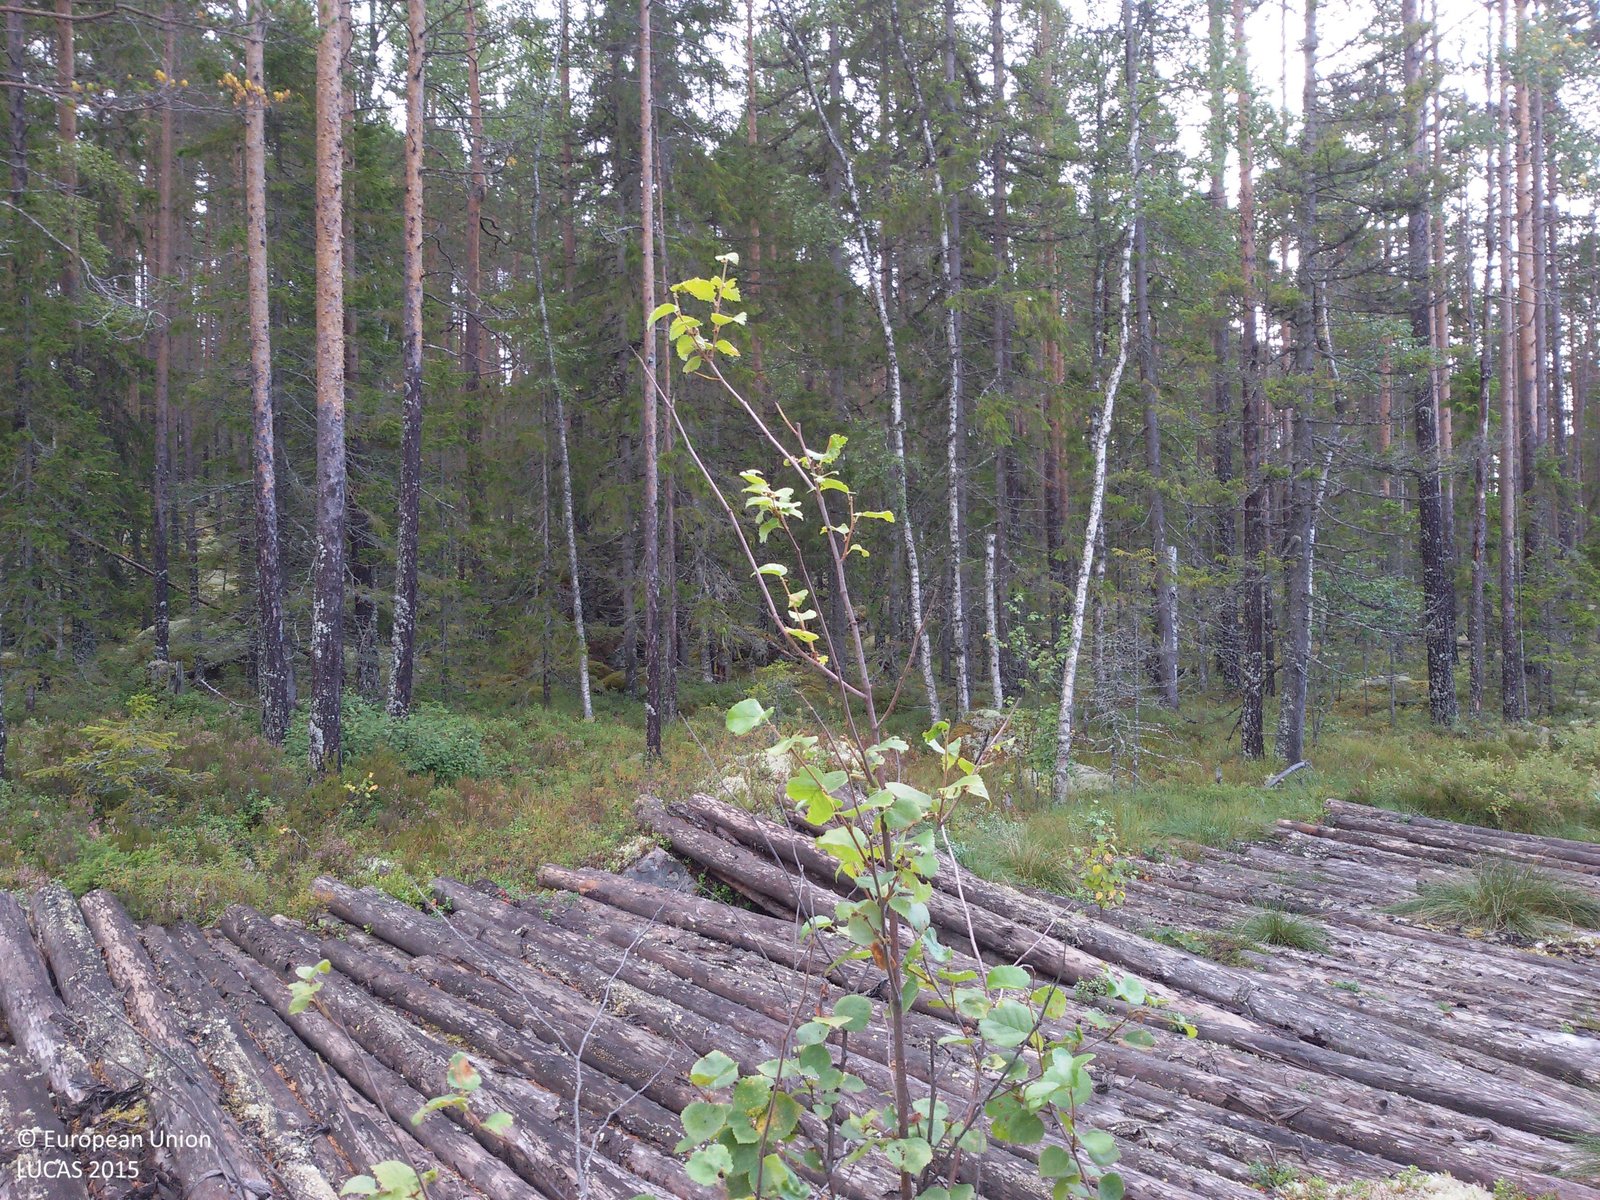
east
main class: Woodland
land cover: Pine dominated mixed woodland
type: boreal forest
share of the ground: 50 - 75 %
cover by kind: herbaceous plants 40 %, coniferous forest trees 30 %, broadleaved forest trees 30 %
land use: Forestry
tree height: > 5 m
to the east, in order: Pine dominated mixed woodland; Artificial constructions in urban areas; Pine dominated coniferous woodland; Rivers and streams; Pine dominated mixed woodland
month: September
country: SE
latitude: 61.0724
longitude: 15.3417
